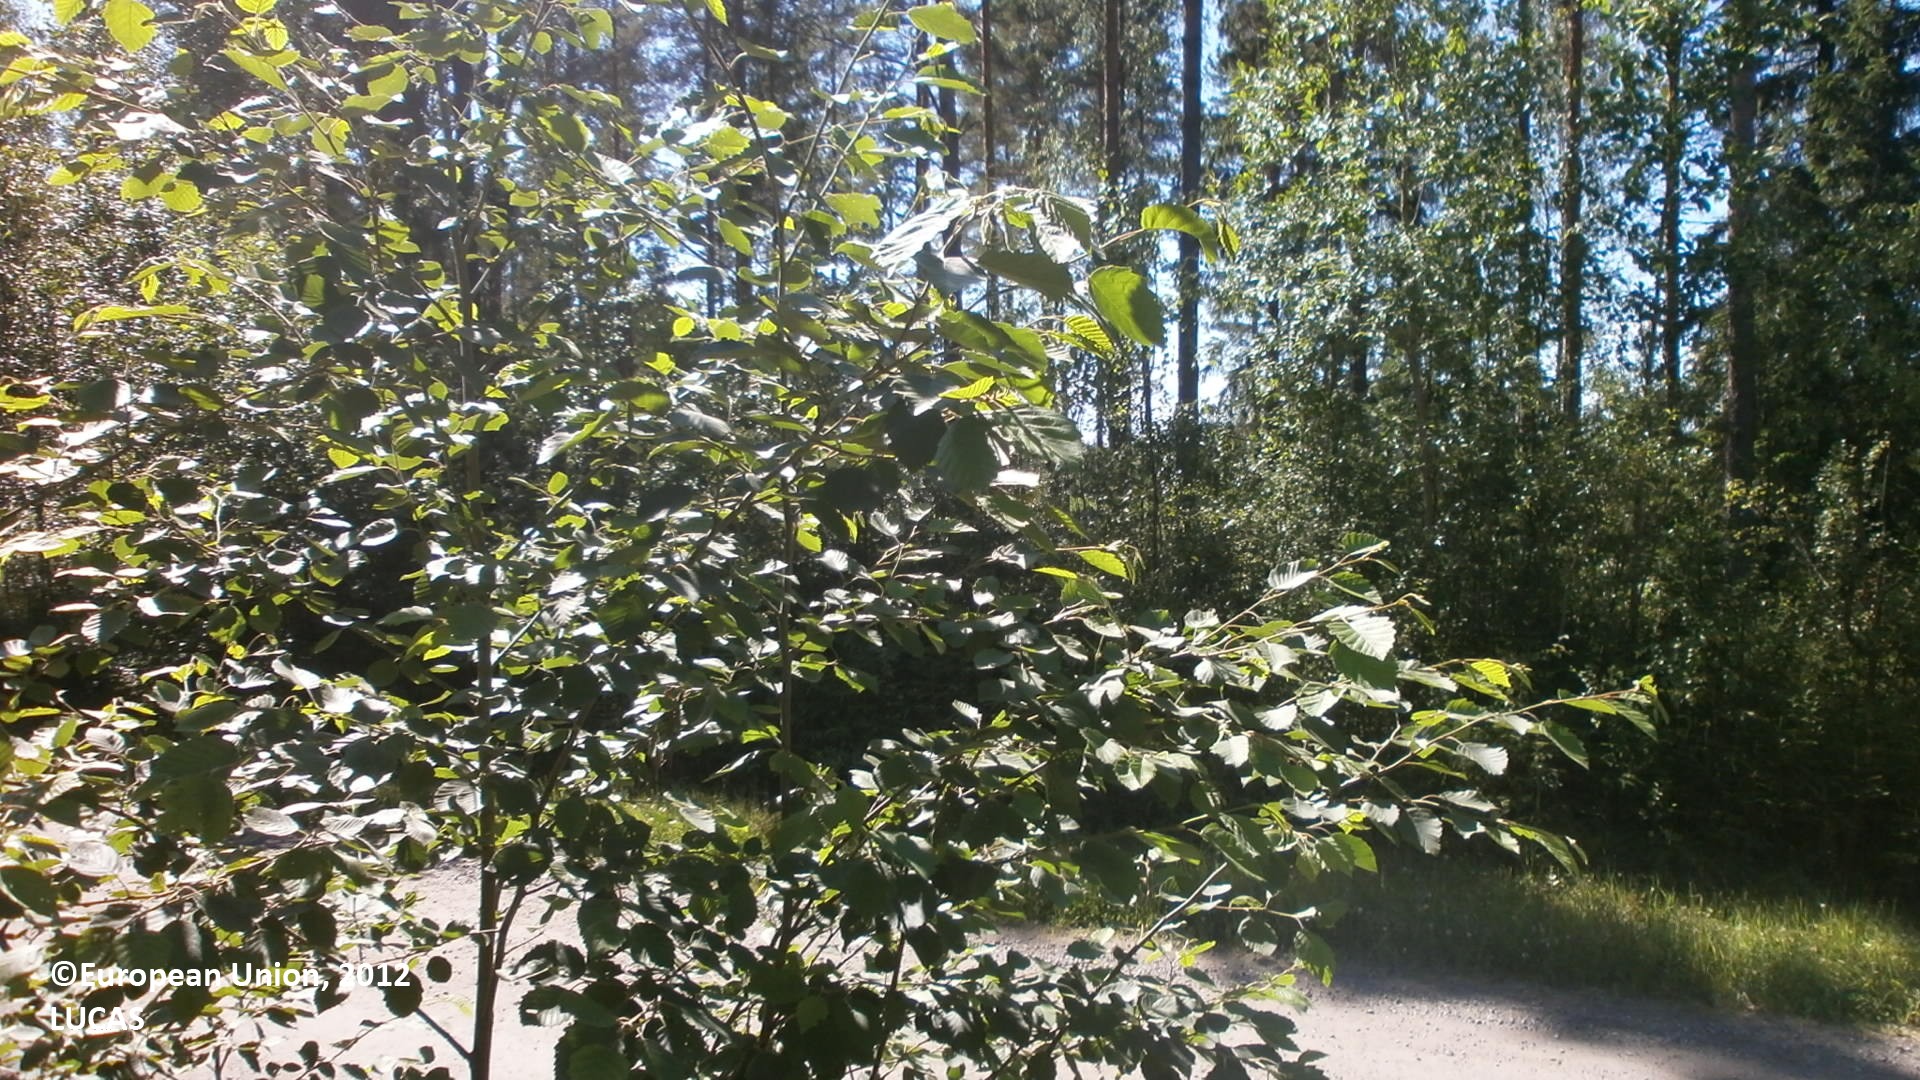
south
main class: Woodland
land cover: Pine dominated coniferous woodland
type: boreal forest
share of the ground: 50 - 75 %
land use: Forestry
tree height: > 5 m
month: July
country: FI
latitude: 64.1110
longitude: 24.3368
